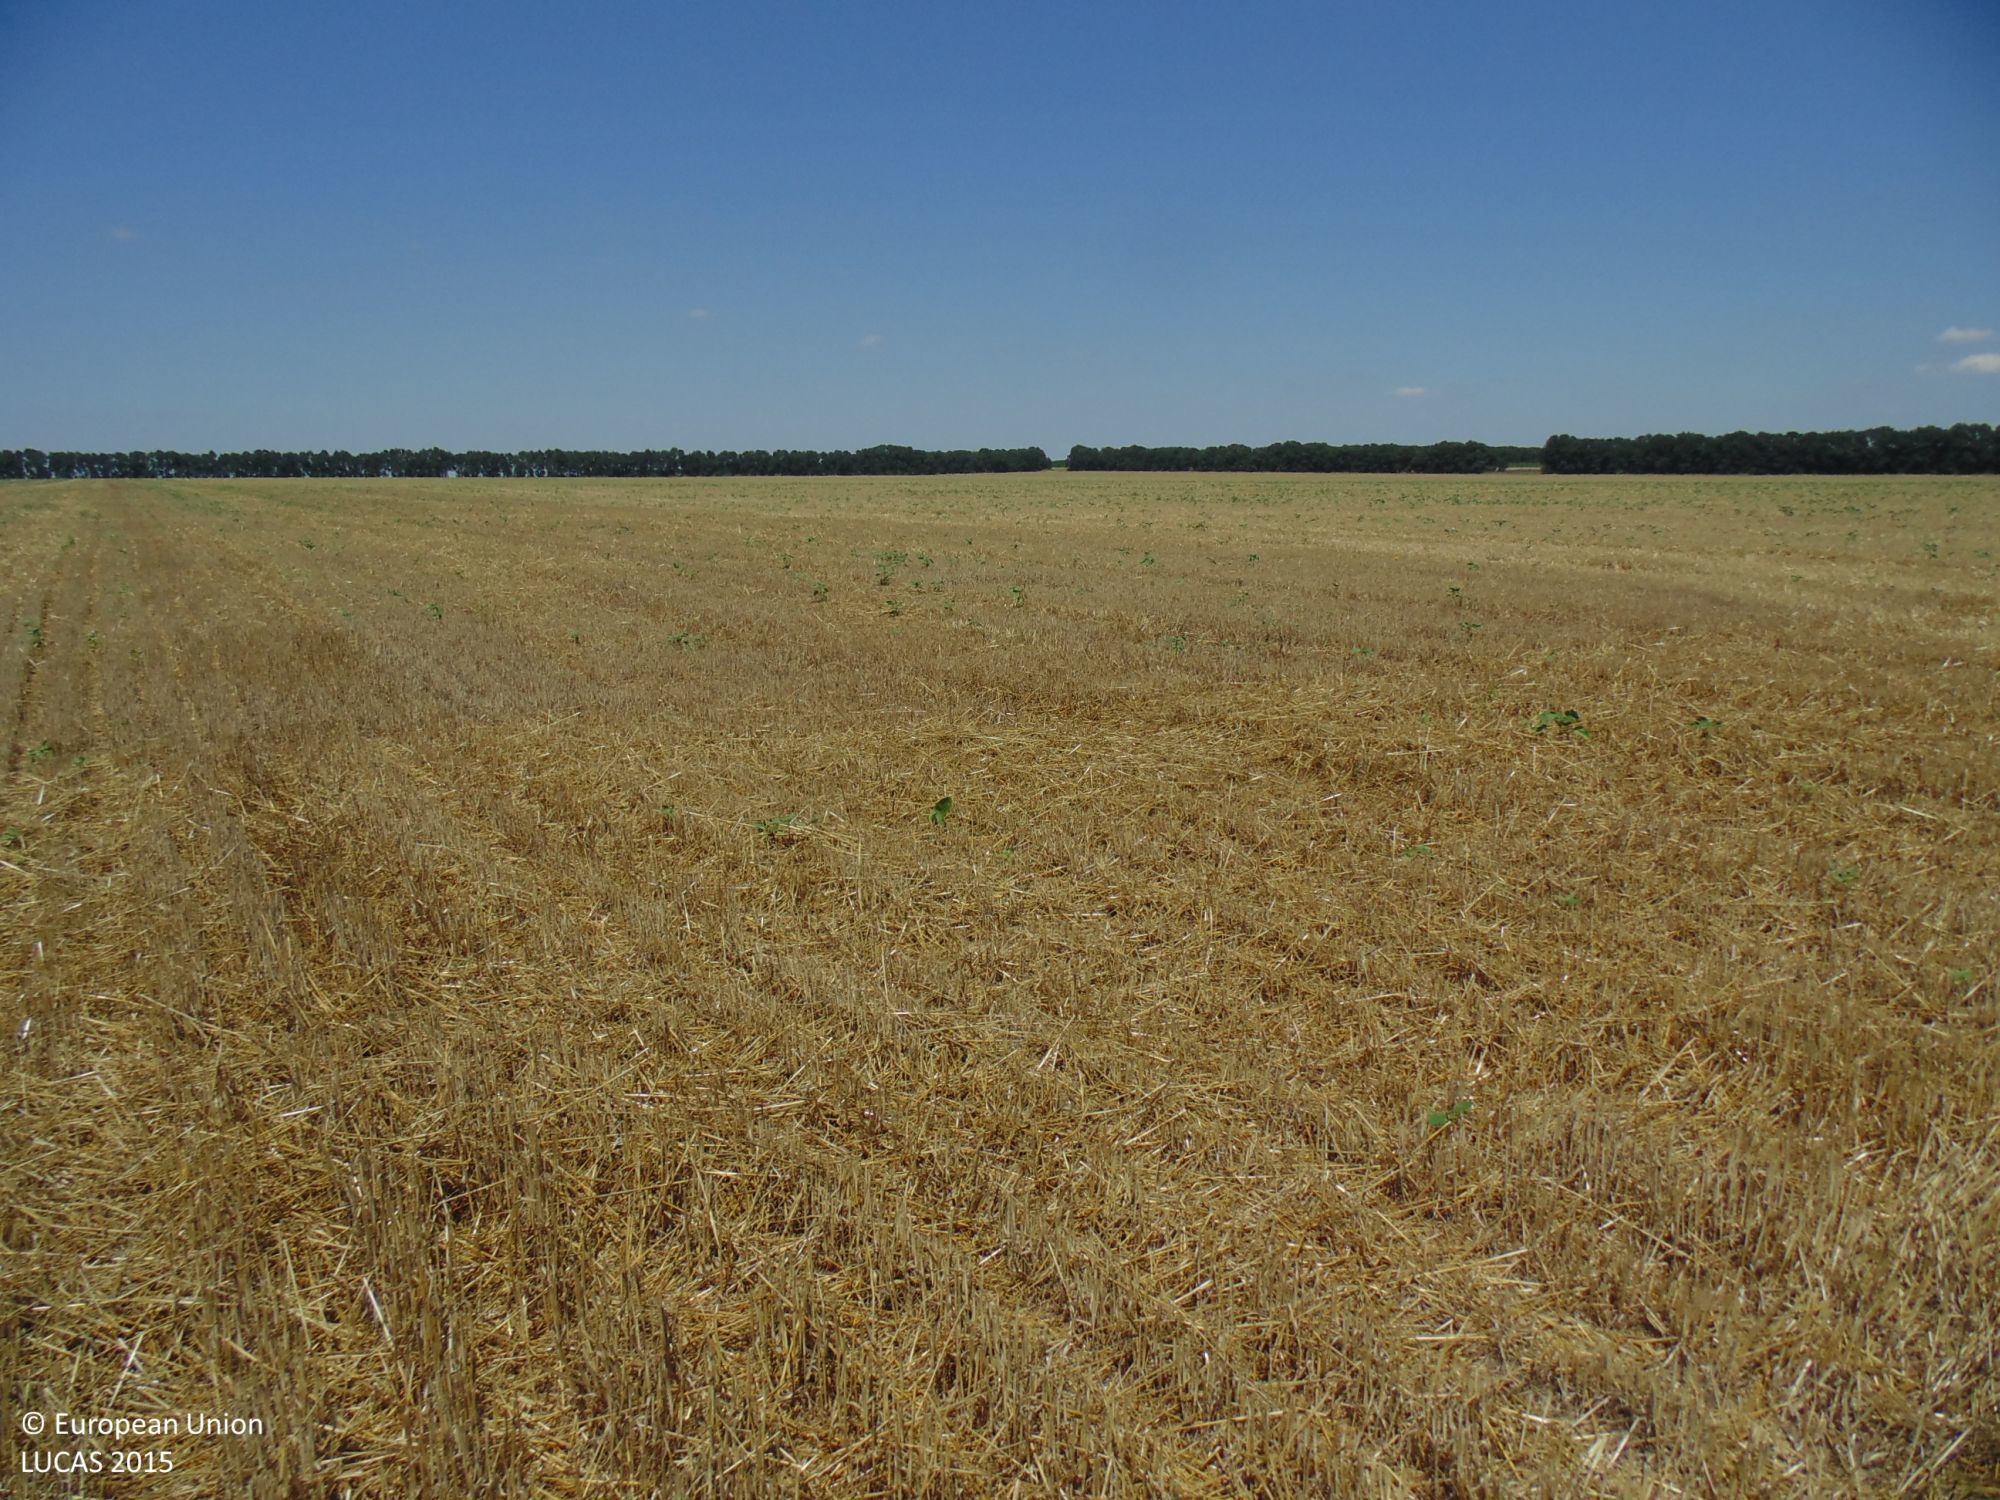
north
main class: Cropland
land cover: Common wheat
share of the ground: > 75 %
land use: Agriculture (excluding fallow land and kitchen gardens)
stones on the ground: < 10 %
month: August
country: BG
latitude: 43.5873
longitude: 28.1215
